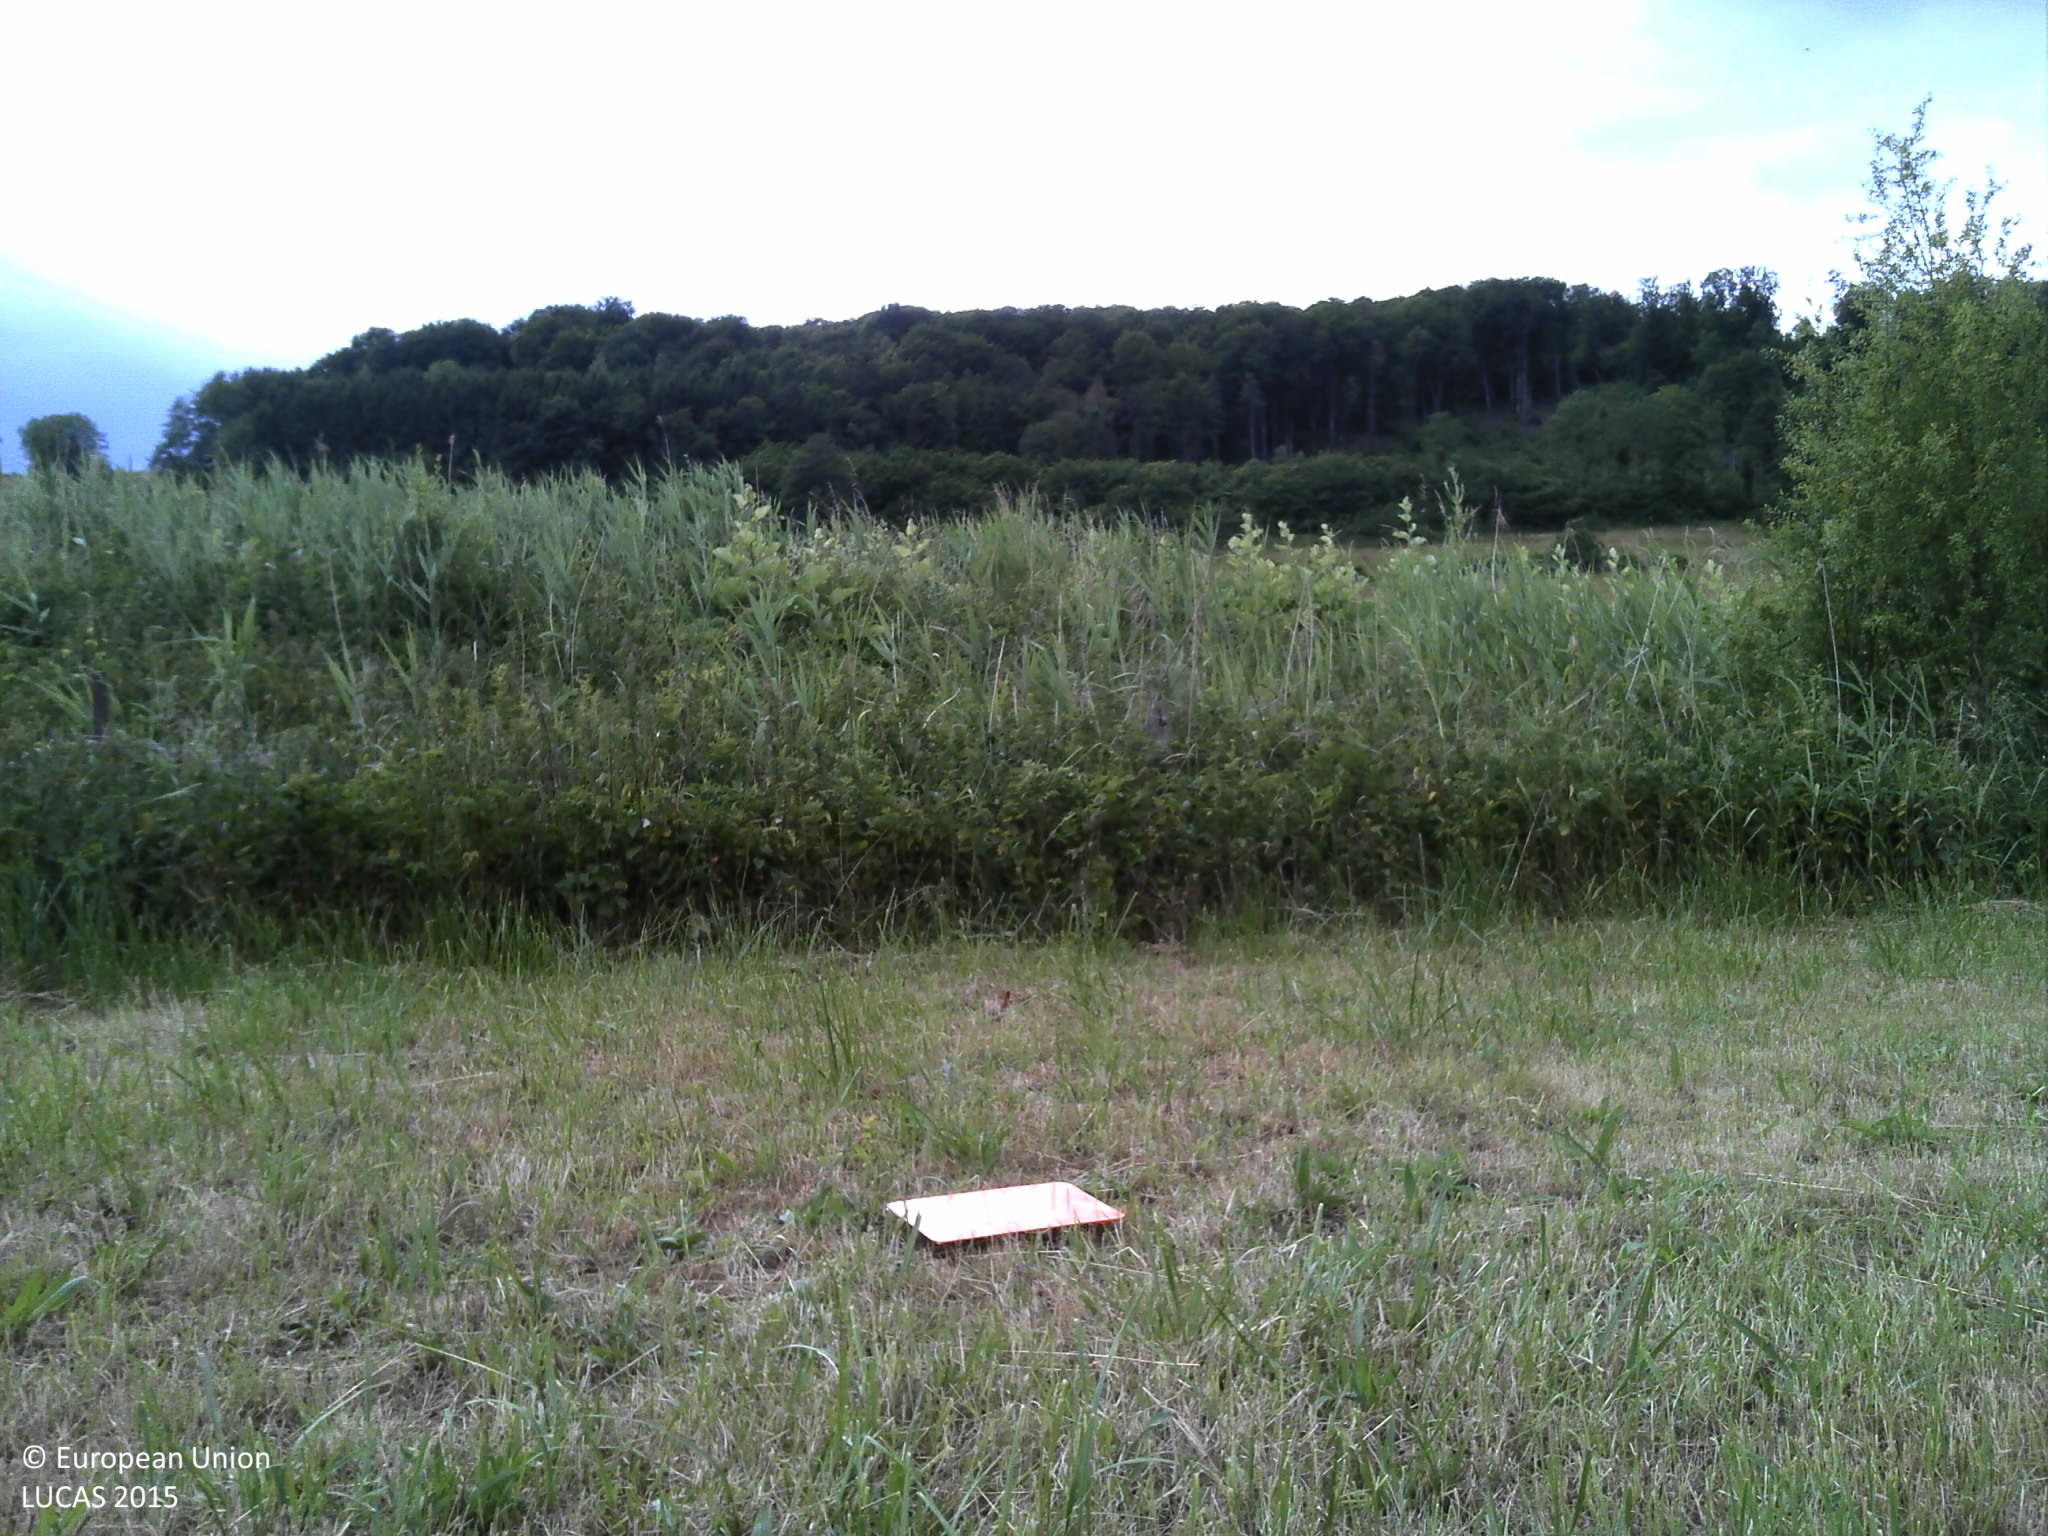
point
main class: Grassland
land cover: Grassland without tree/shrub cover
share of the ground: > 75 %
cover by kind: herbaceous plants 100 %
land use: Agriculture (excluding fallow land and kitchen gardens)
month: June
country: FR
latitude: 49.6346
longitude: 4.8325
